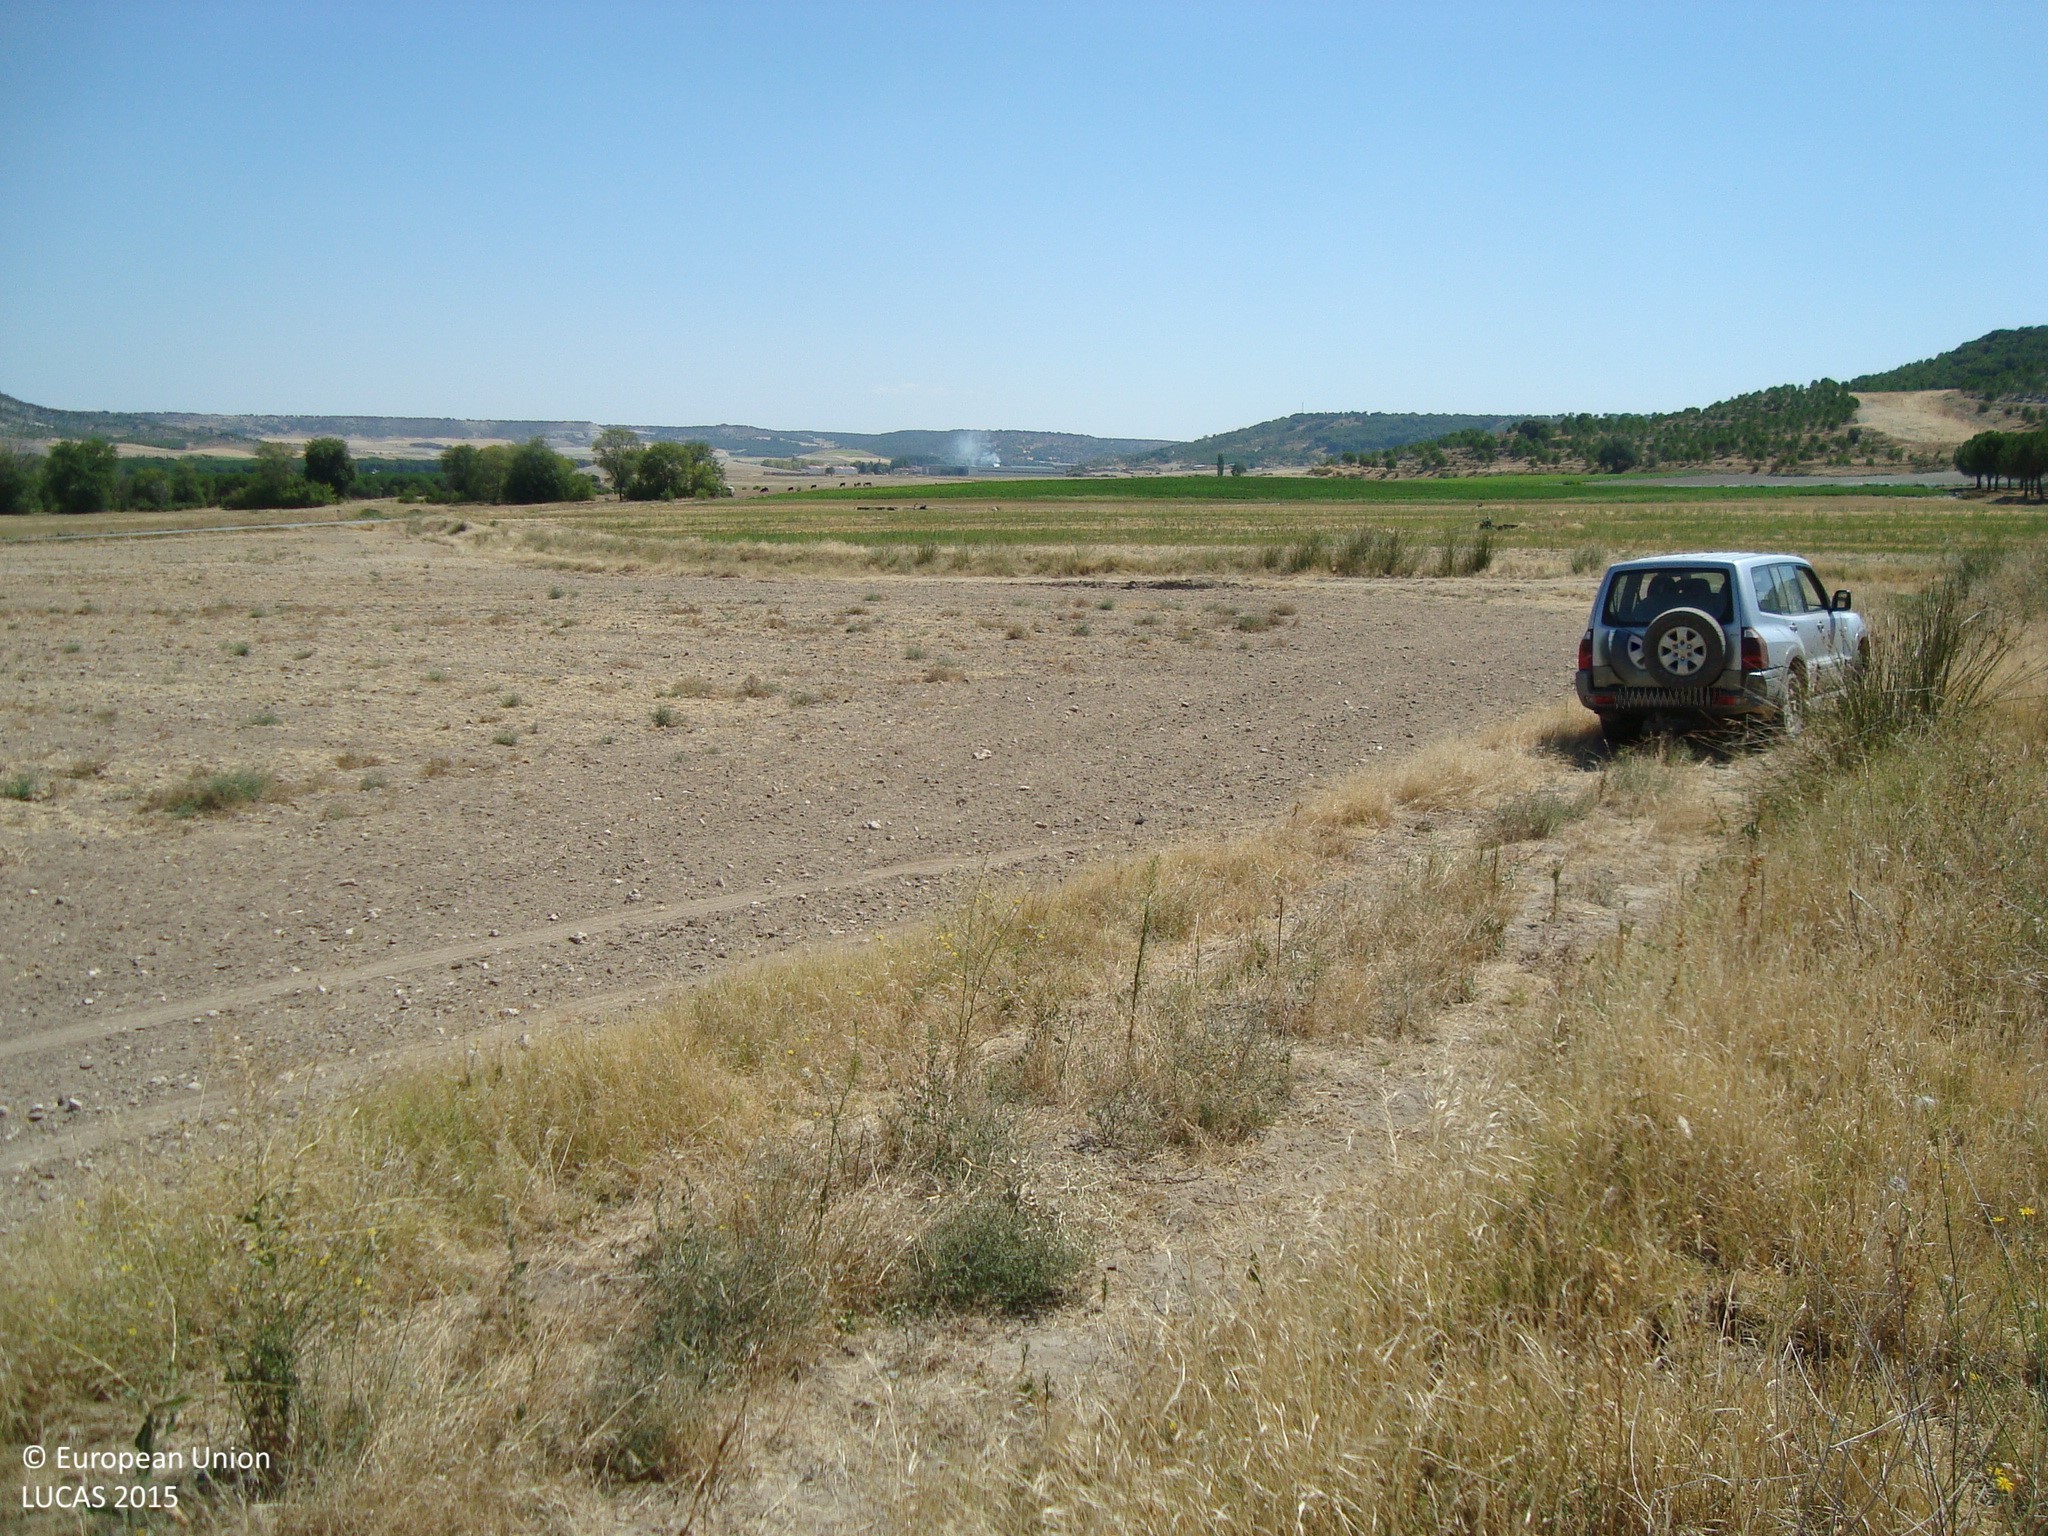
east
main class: Woodland
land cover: Pine dominated coniferous woodland
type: coniferous forest of the mediterranean region
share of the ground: 25 - 50 %
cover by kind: herbaceous plants 60 %, coniferous forest trees 40 %
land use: Forestry
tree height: < 5 m
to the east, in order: Pine dominated coniferous woodland; Grass margins; Tracks; Grass margins; Other bare soil; Tracks; Grass margins; Other bare soil; Barley; Artificial constructions; Barley
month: August
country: ES
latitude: 41.4066
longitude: -4.5980
